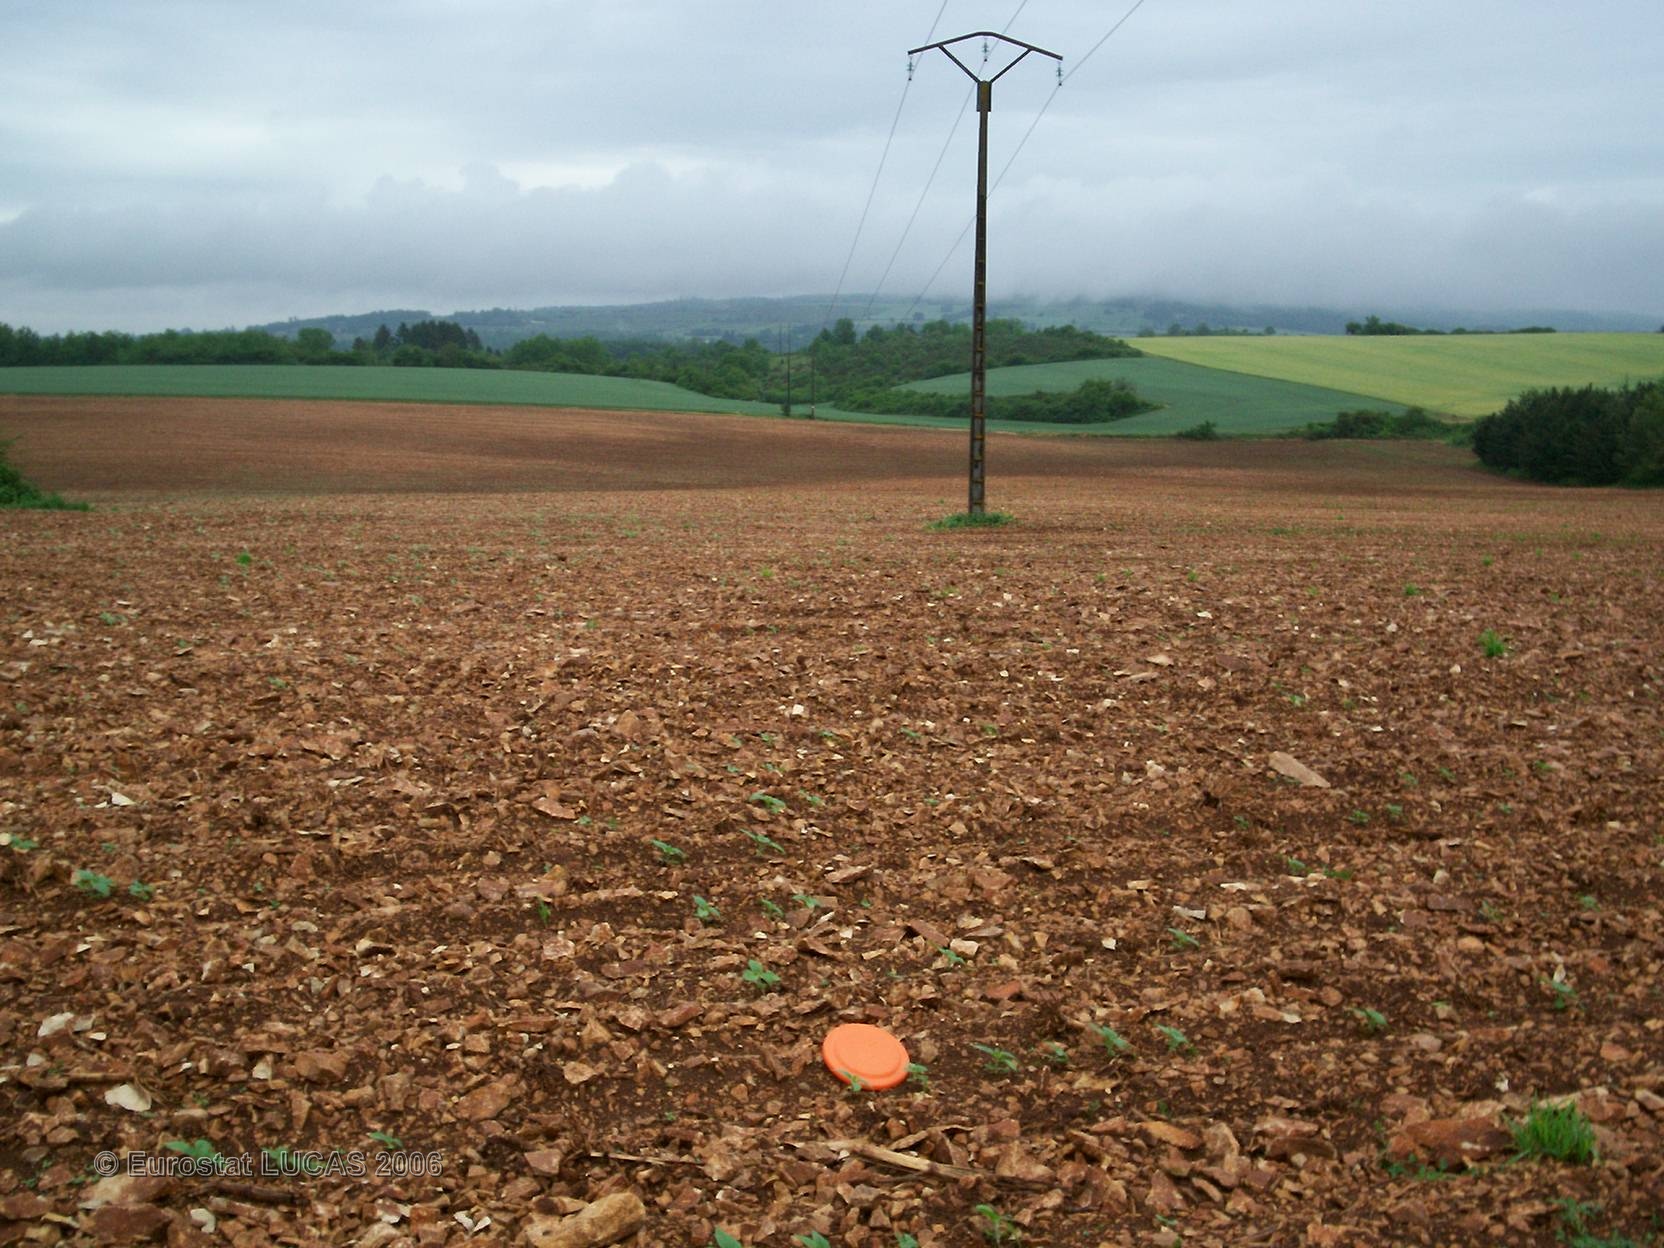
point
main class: Cropland
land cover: Sunflower
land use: Agriculture (excluding fallow land and kitchen gardens)
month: May
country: FR
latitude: 45.6558
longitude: 0.5027
